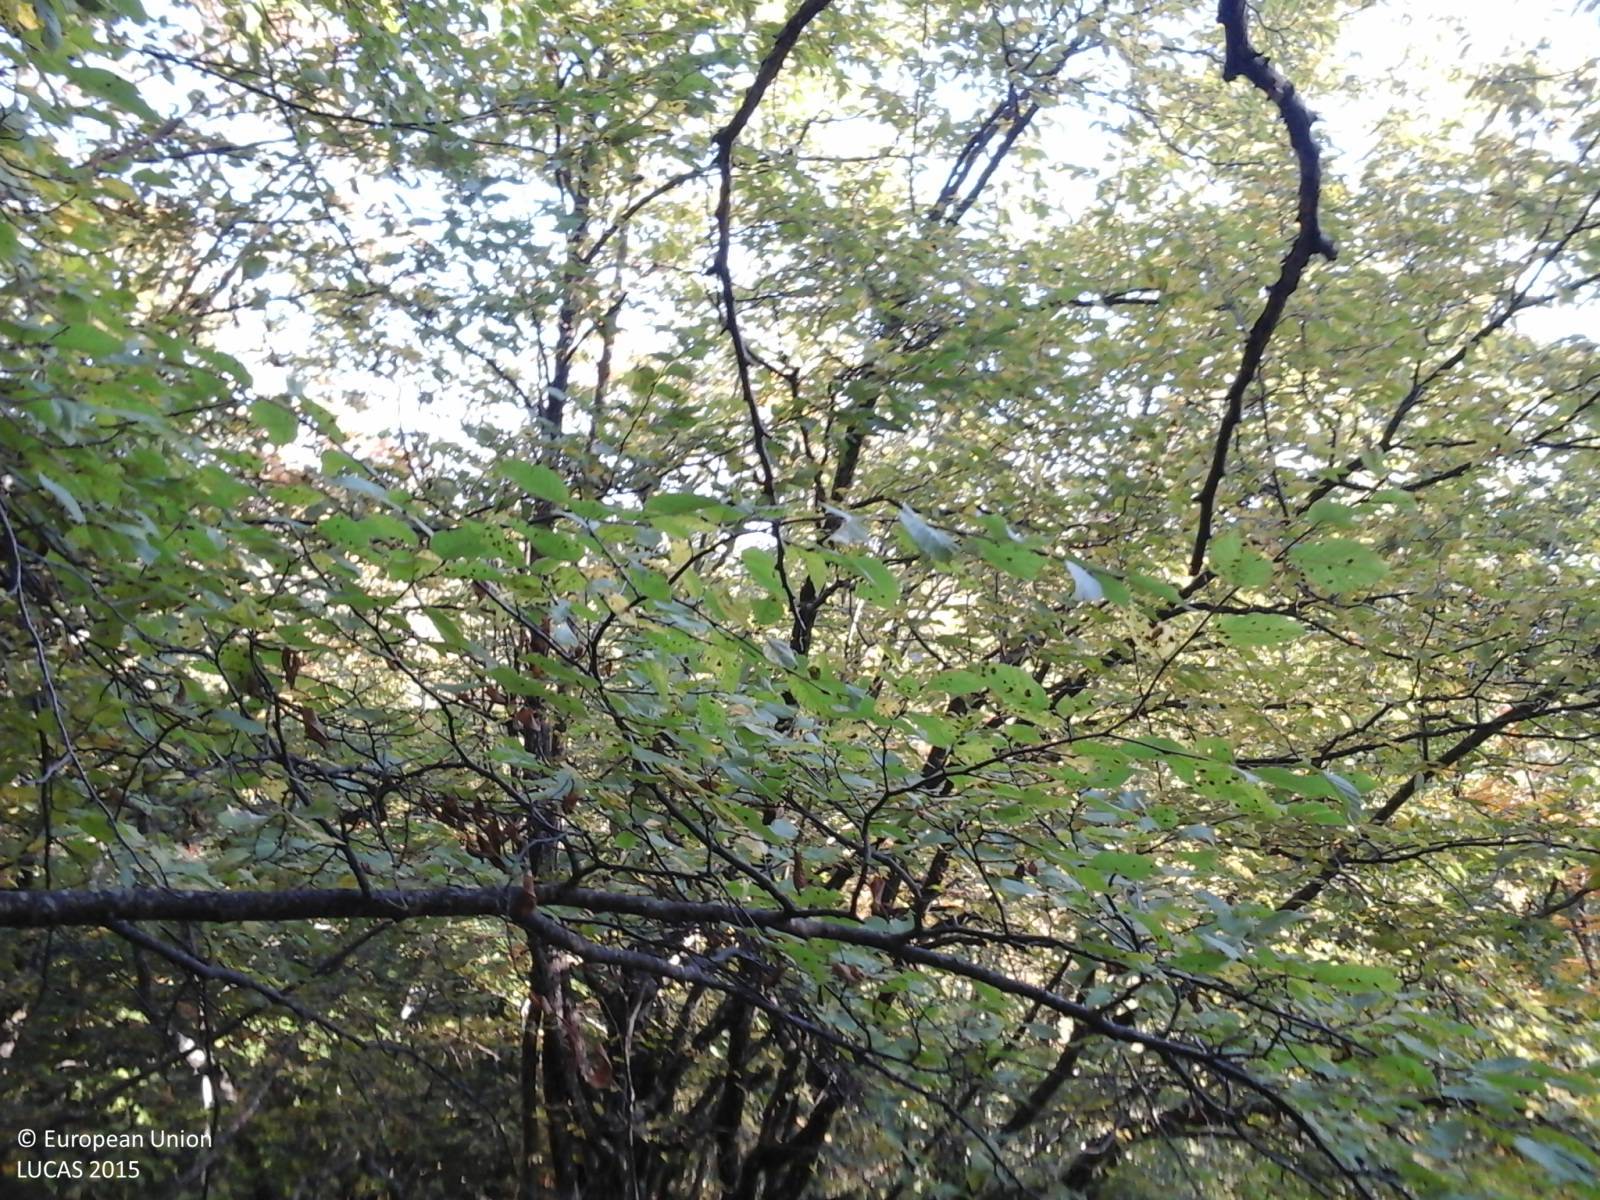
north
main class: Woodland
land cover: Broadleaved woodland
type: mountainous beech forest
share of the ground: > 75 %
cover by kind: broadleaved forest trees 80 %, shrubs 20 %
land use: Forestry
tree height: > 5 m
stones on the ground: < 10 %
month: October
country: IT
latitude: 42.7387
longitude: 12.9105
